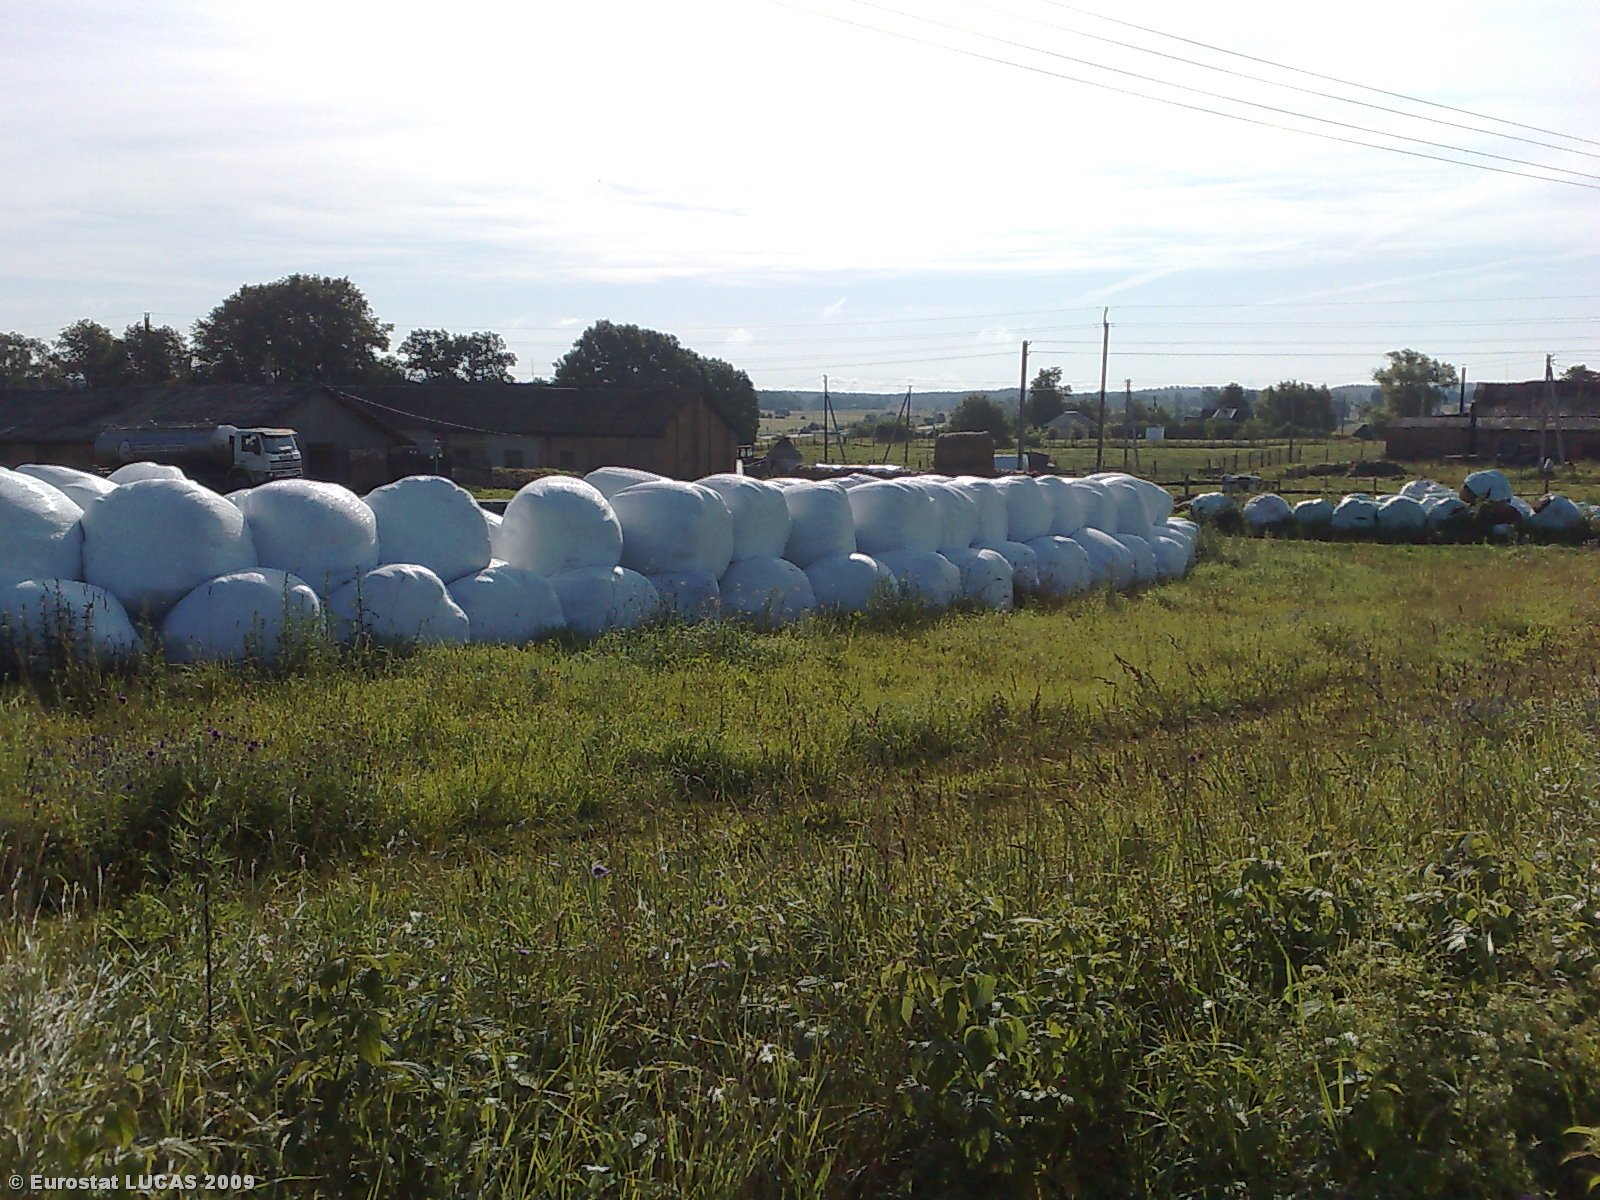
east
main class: Grassland
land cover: Grassland without tree/shrub cover
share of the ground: > 75 %
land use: Agriculture (excluding fallow land and kitchen gardens)
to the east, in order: Grassland without tree/shrub cover; Tracks; Electric lines; Grassland without tree/shrub cover; Artificial constructions in urban areas; Grassland without tree/shrub cover; Electric lines; Paved roads, cycling and walking lanes; Grassland without tree/shrub cover
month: July
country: LT
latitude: 55.8296
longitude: 22.8534
